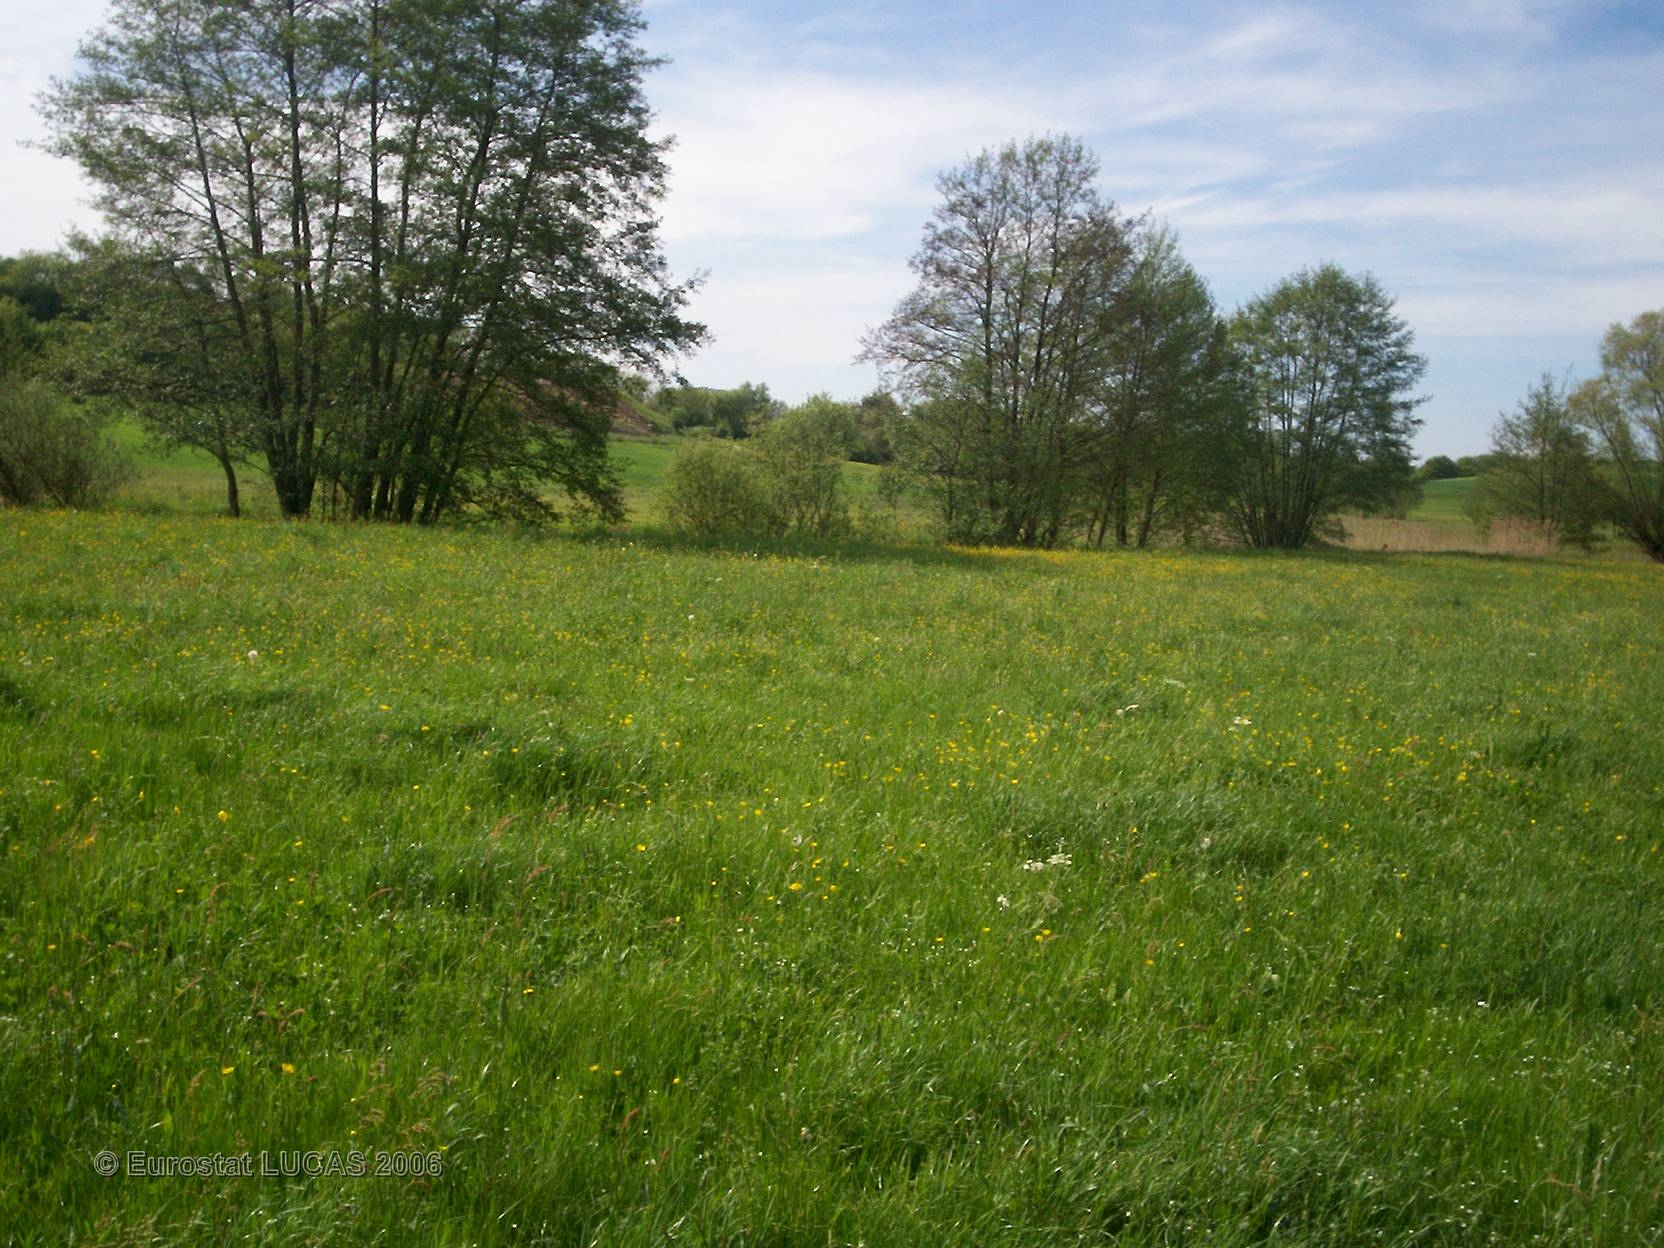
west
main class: Grassland
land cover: Grassland without tree/shrub cover
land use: Agriculture (excluding fallow land and kitchen gardens)
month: May
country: FR
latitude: 48.8328
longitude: 7.0716
